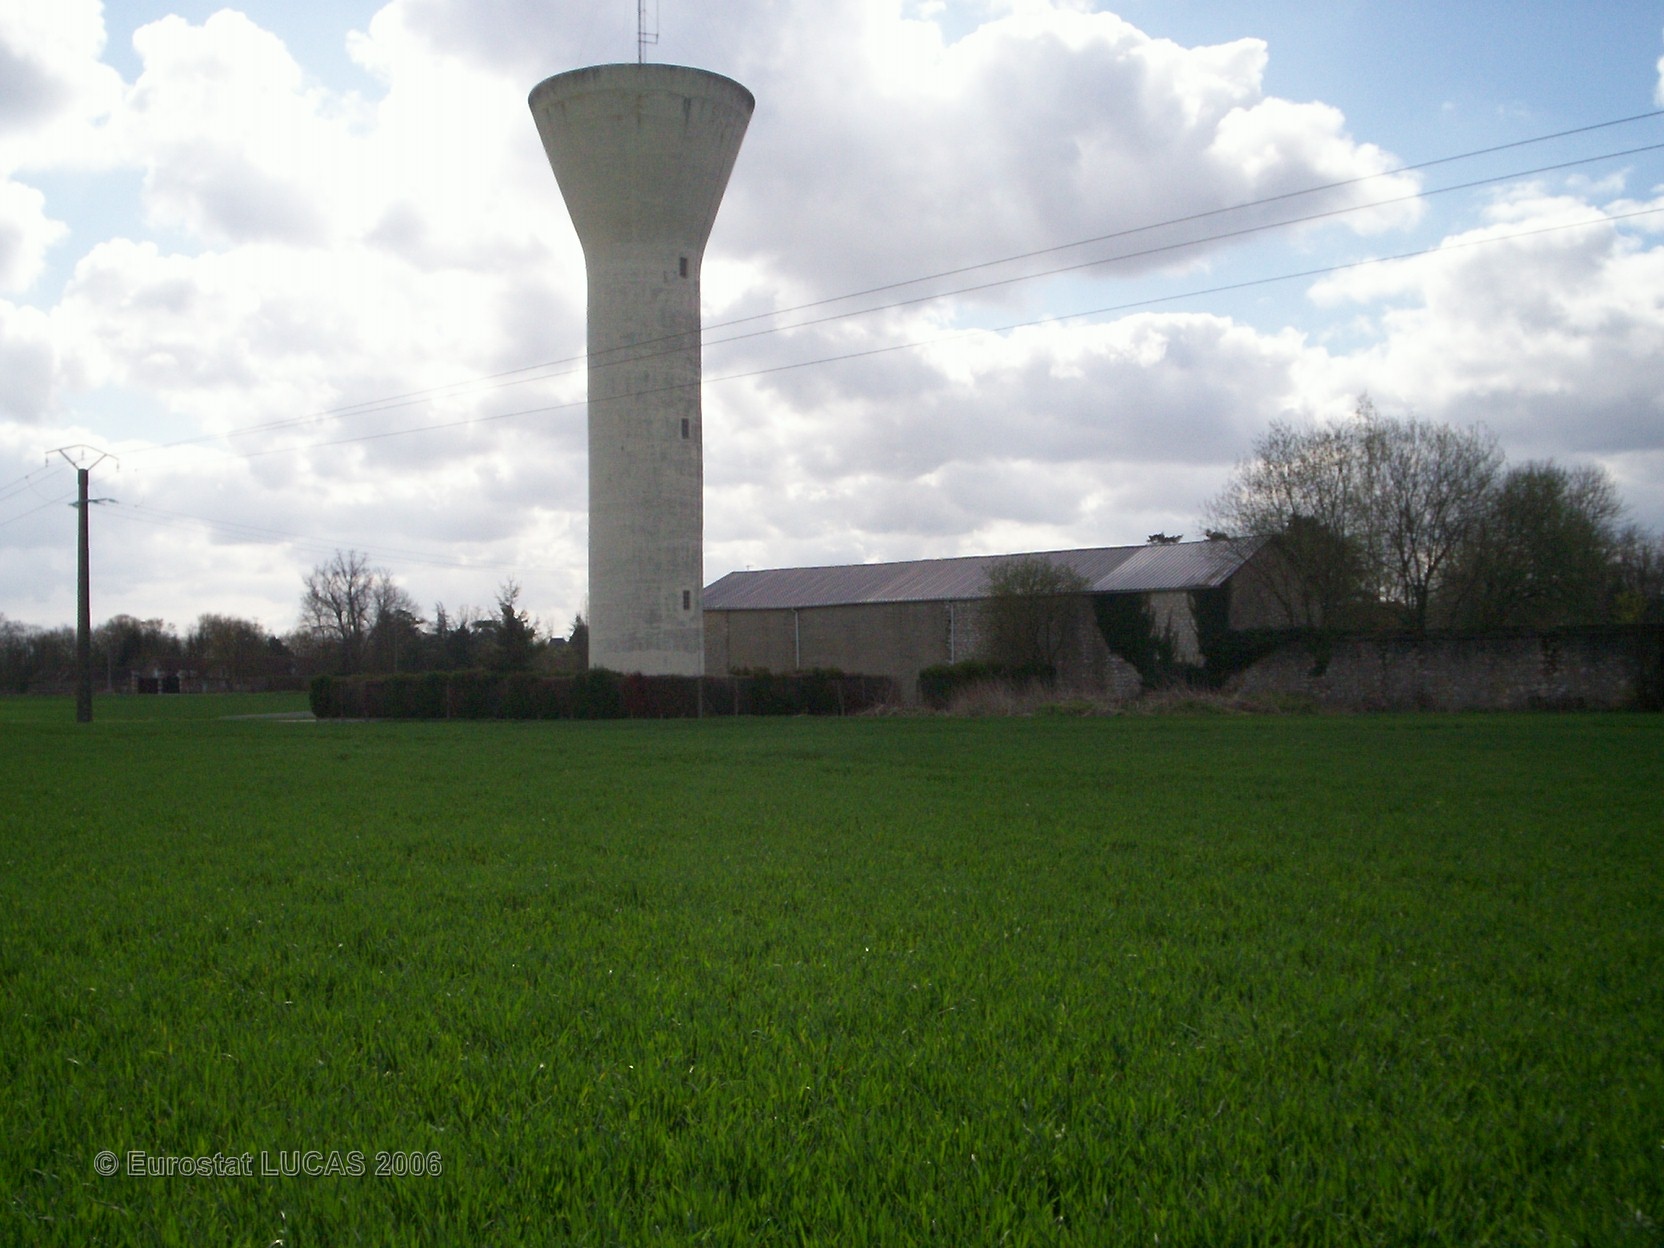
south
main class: Cropland
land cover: Common wheat
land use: Agriculture (excluding fallow land and kitchen gardens)
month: April
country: FR
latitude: 48.4906
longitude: 2.7515
